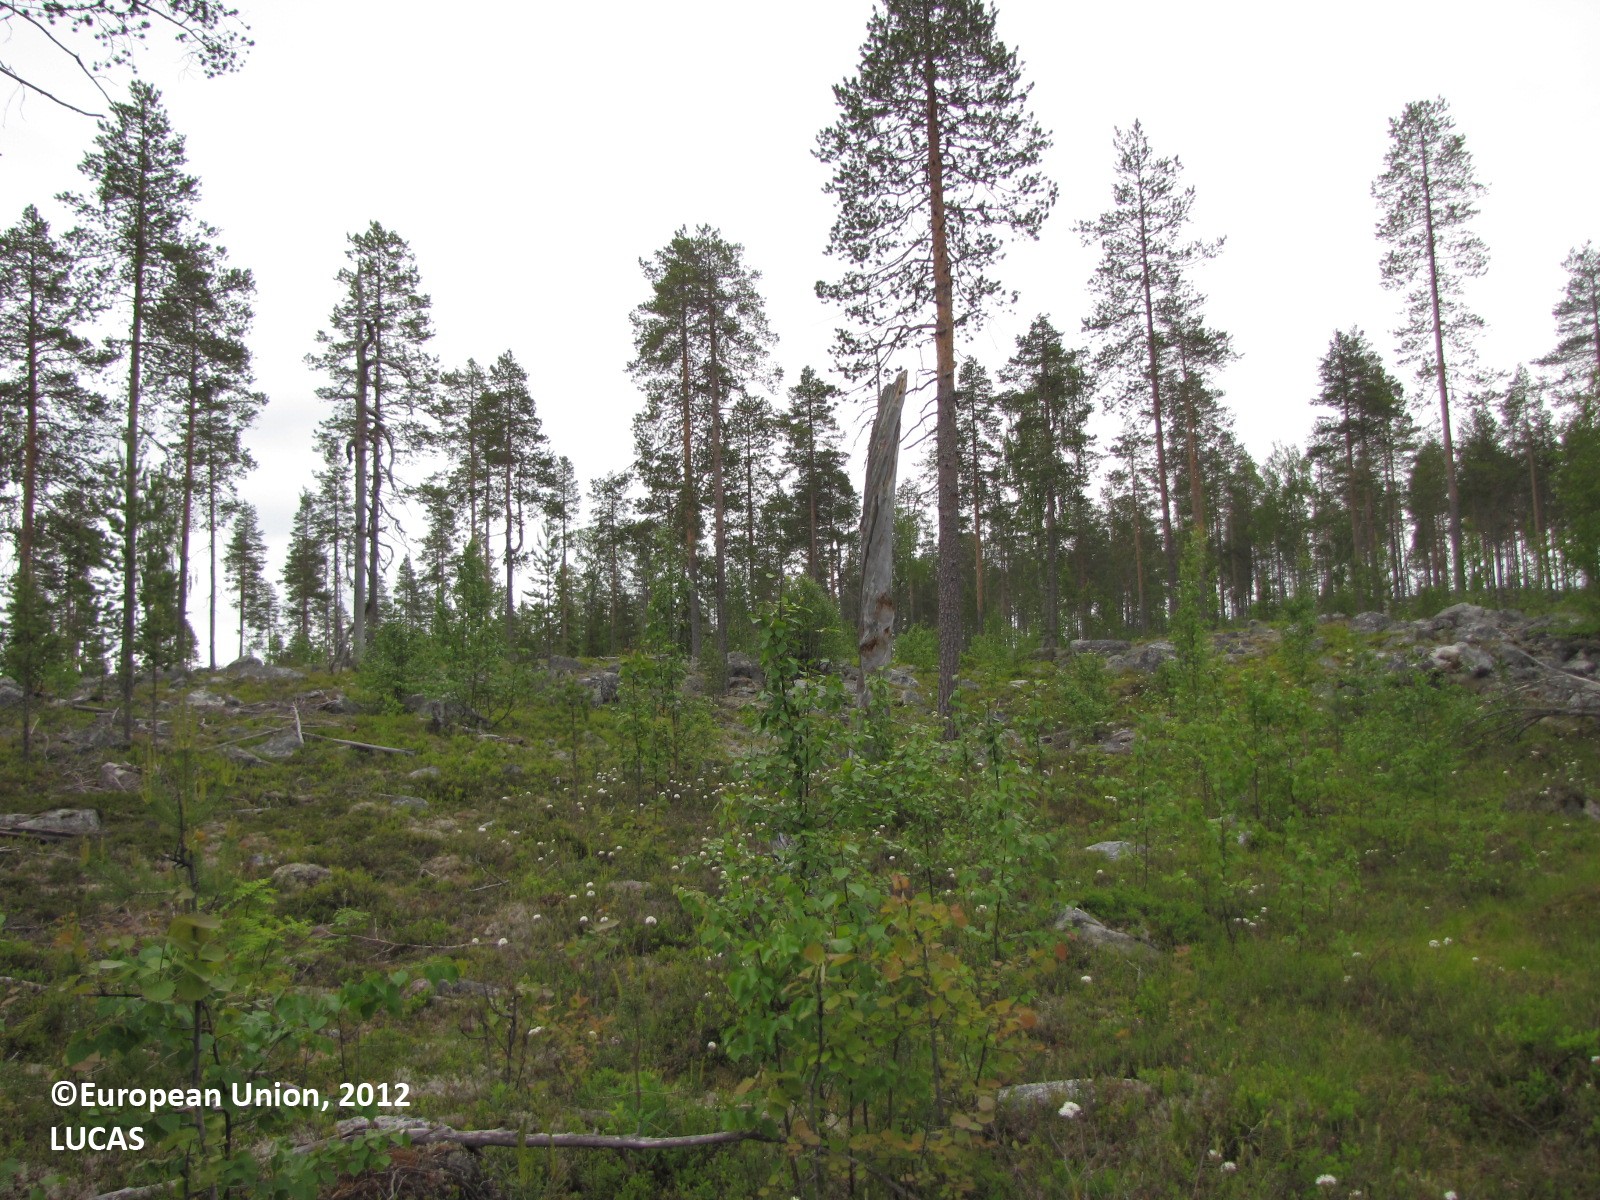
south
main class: Woodland
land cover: Pine dominated mixed woodland
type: boreal forest
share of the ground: 10 - 25 %
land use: Forestry
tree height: > 5 m
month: June
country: FI
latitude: 66.1477
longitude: 24.8823
